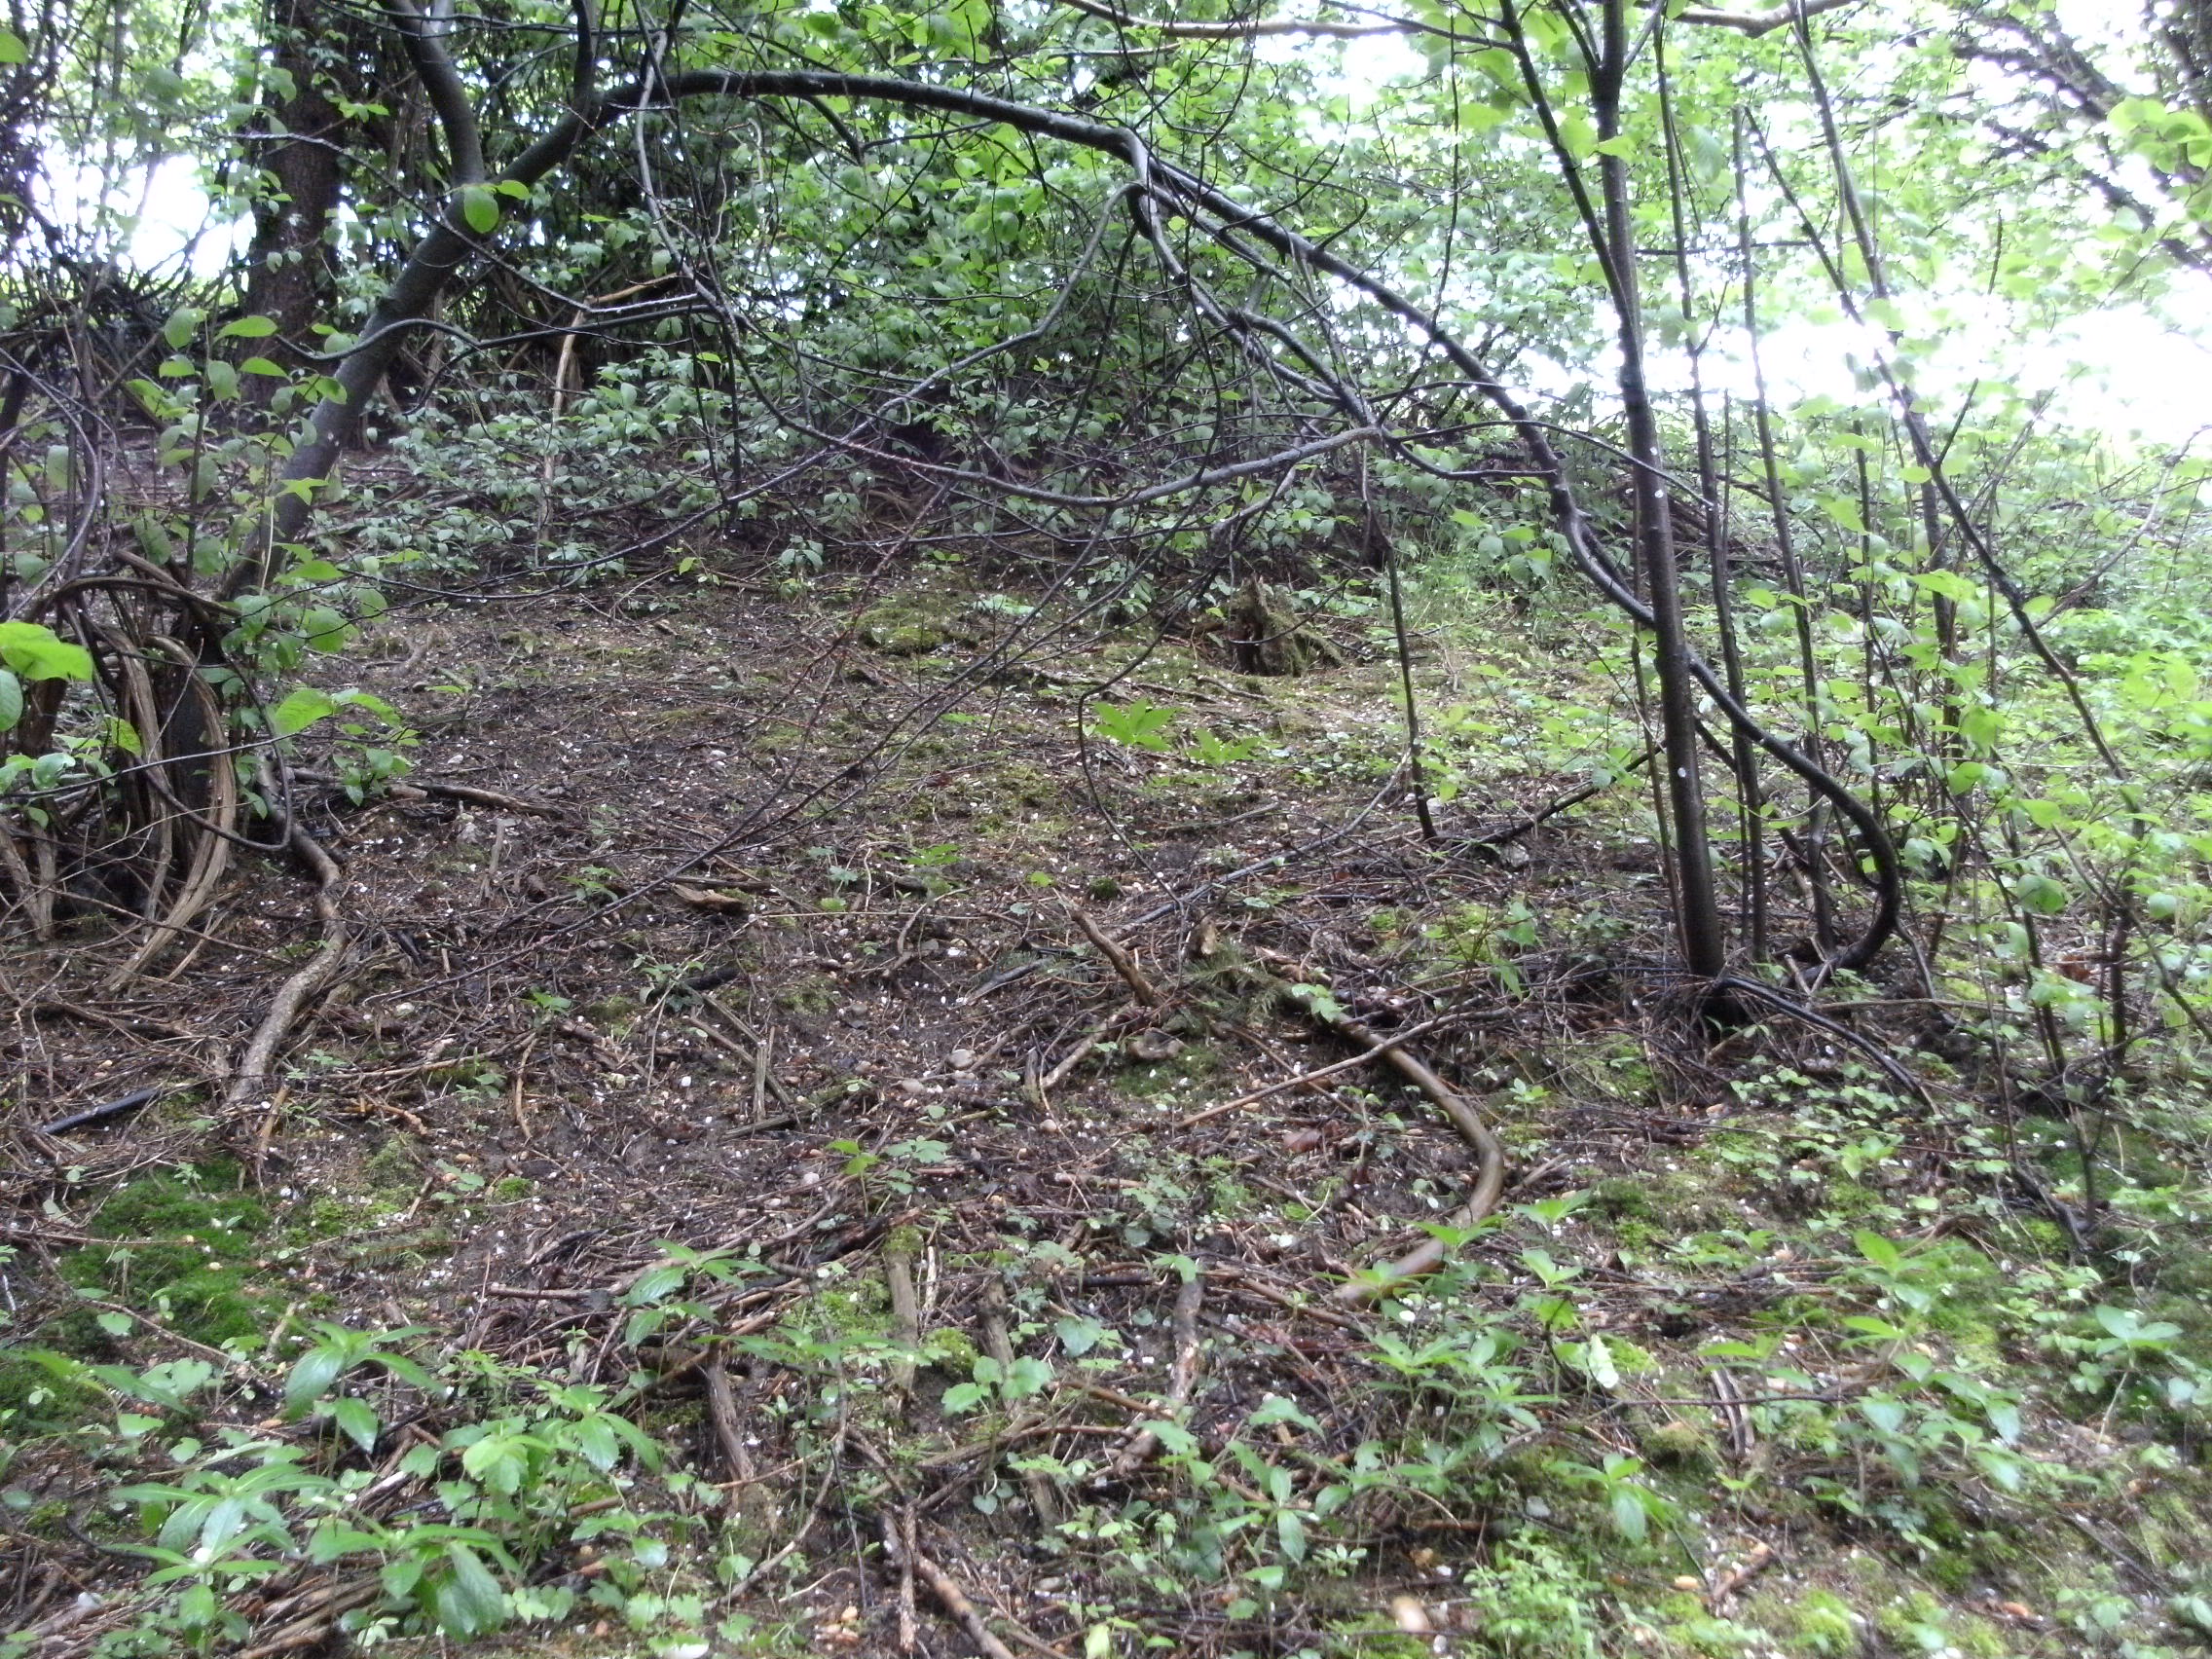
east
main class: Woodland
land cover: Broadleaved woodland
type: mesophytic deciduous forest
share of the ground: > 75 %
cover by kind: broadleaved forest trees 50 %, herbaceous plants 25 %, shrubs 20 %, coniferous forest trees 5 %
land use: Forestry
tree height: > 5 m
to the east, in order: Broadleaved woodland; Grassland without tree/shrub cover; Barley; Grass margins; Tracks; Grassland without tree/shrub cover
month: May
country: AT
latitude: 48.1857
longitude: 13.5099
